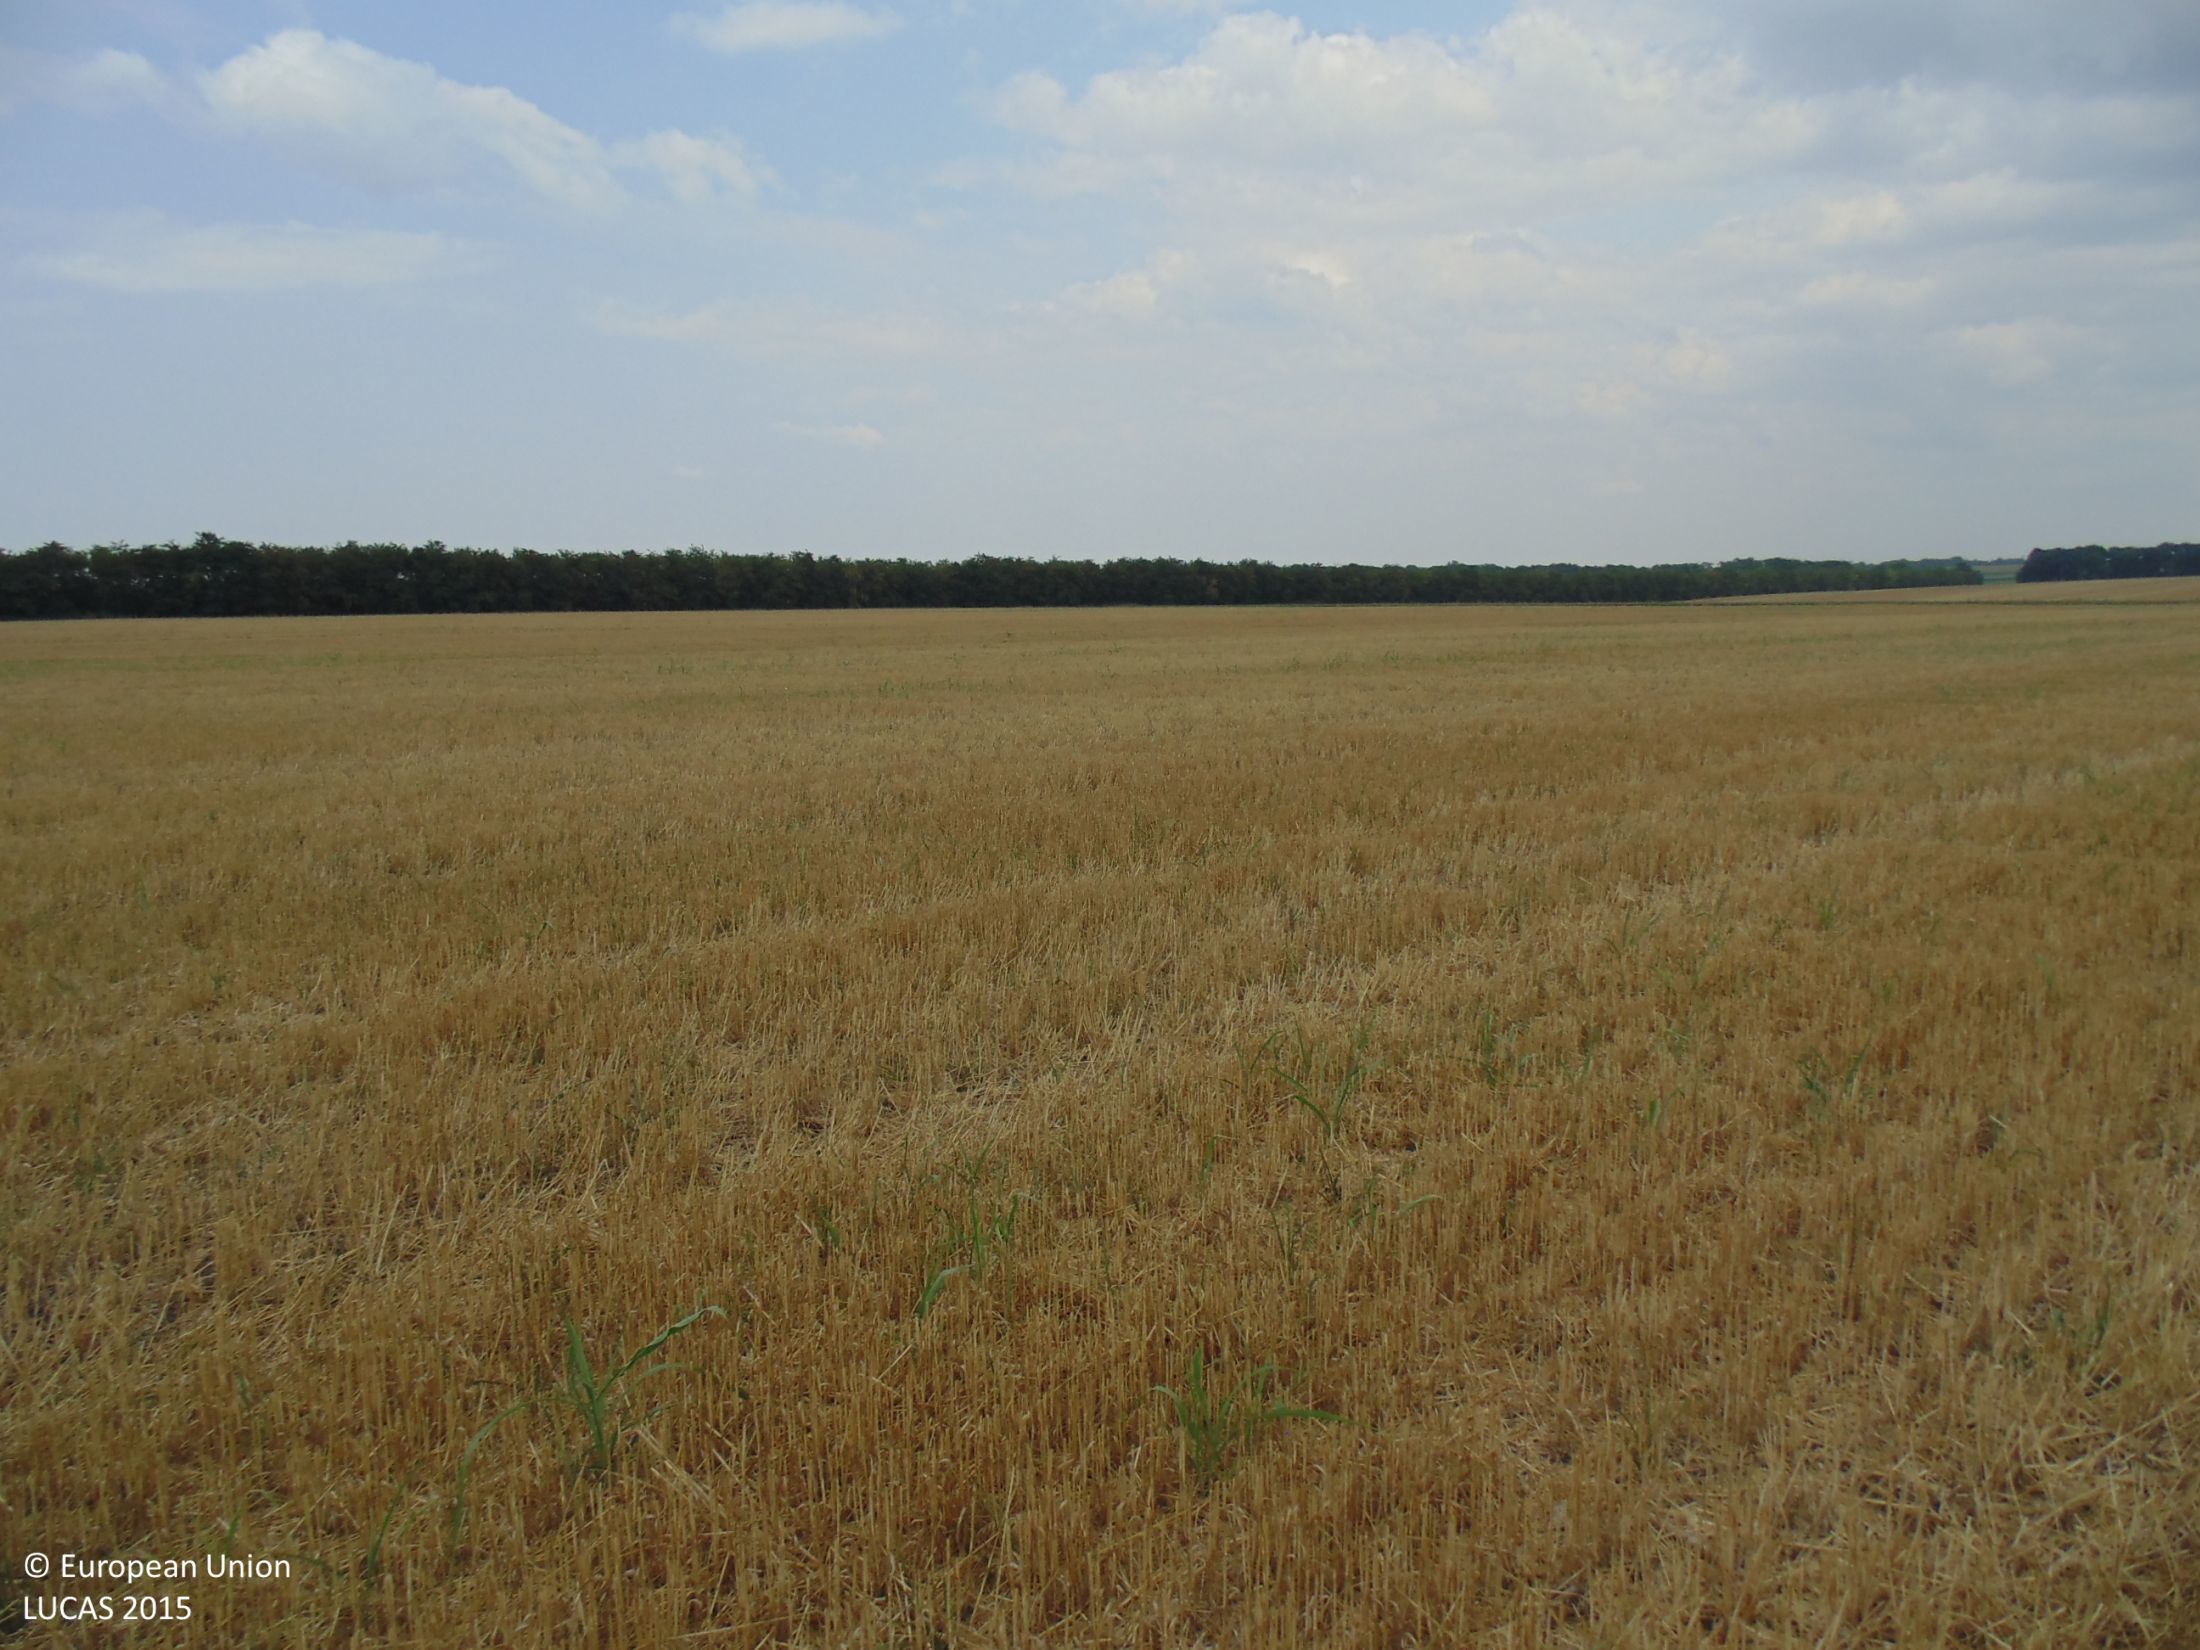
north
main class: Cropland
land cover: Common wheat
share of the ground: 25 - 50 %
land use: Agriculture (excluding fallow land and kitchen gardens)
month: July
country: BG
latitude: 43.7005
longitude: 28.0043
